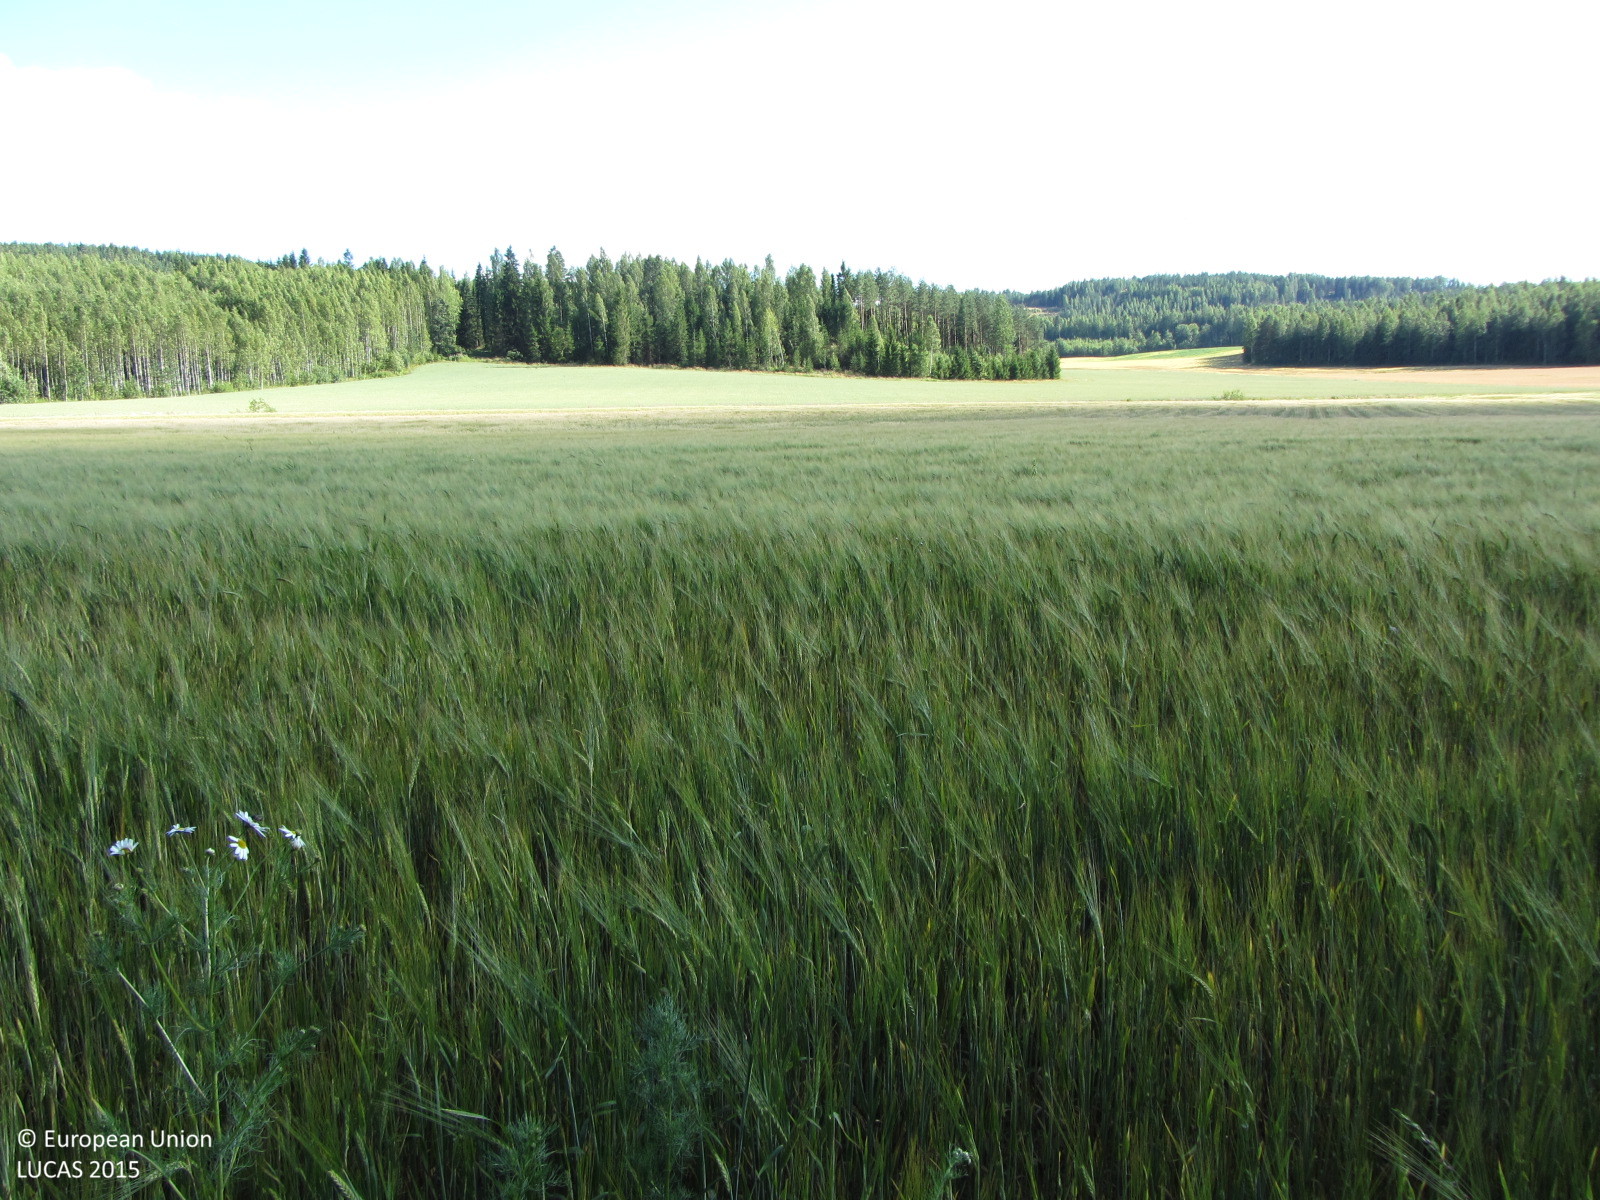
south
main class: Cropland
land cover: Barley
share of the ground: > 75 %
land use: Agriculture (excluding fallow land and kitchen gardens)
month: August
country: FI
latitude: 60.4771
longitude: 23.9026
